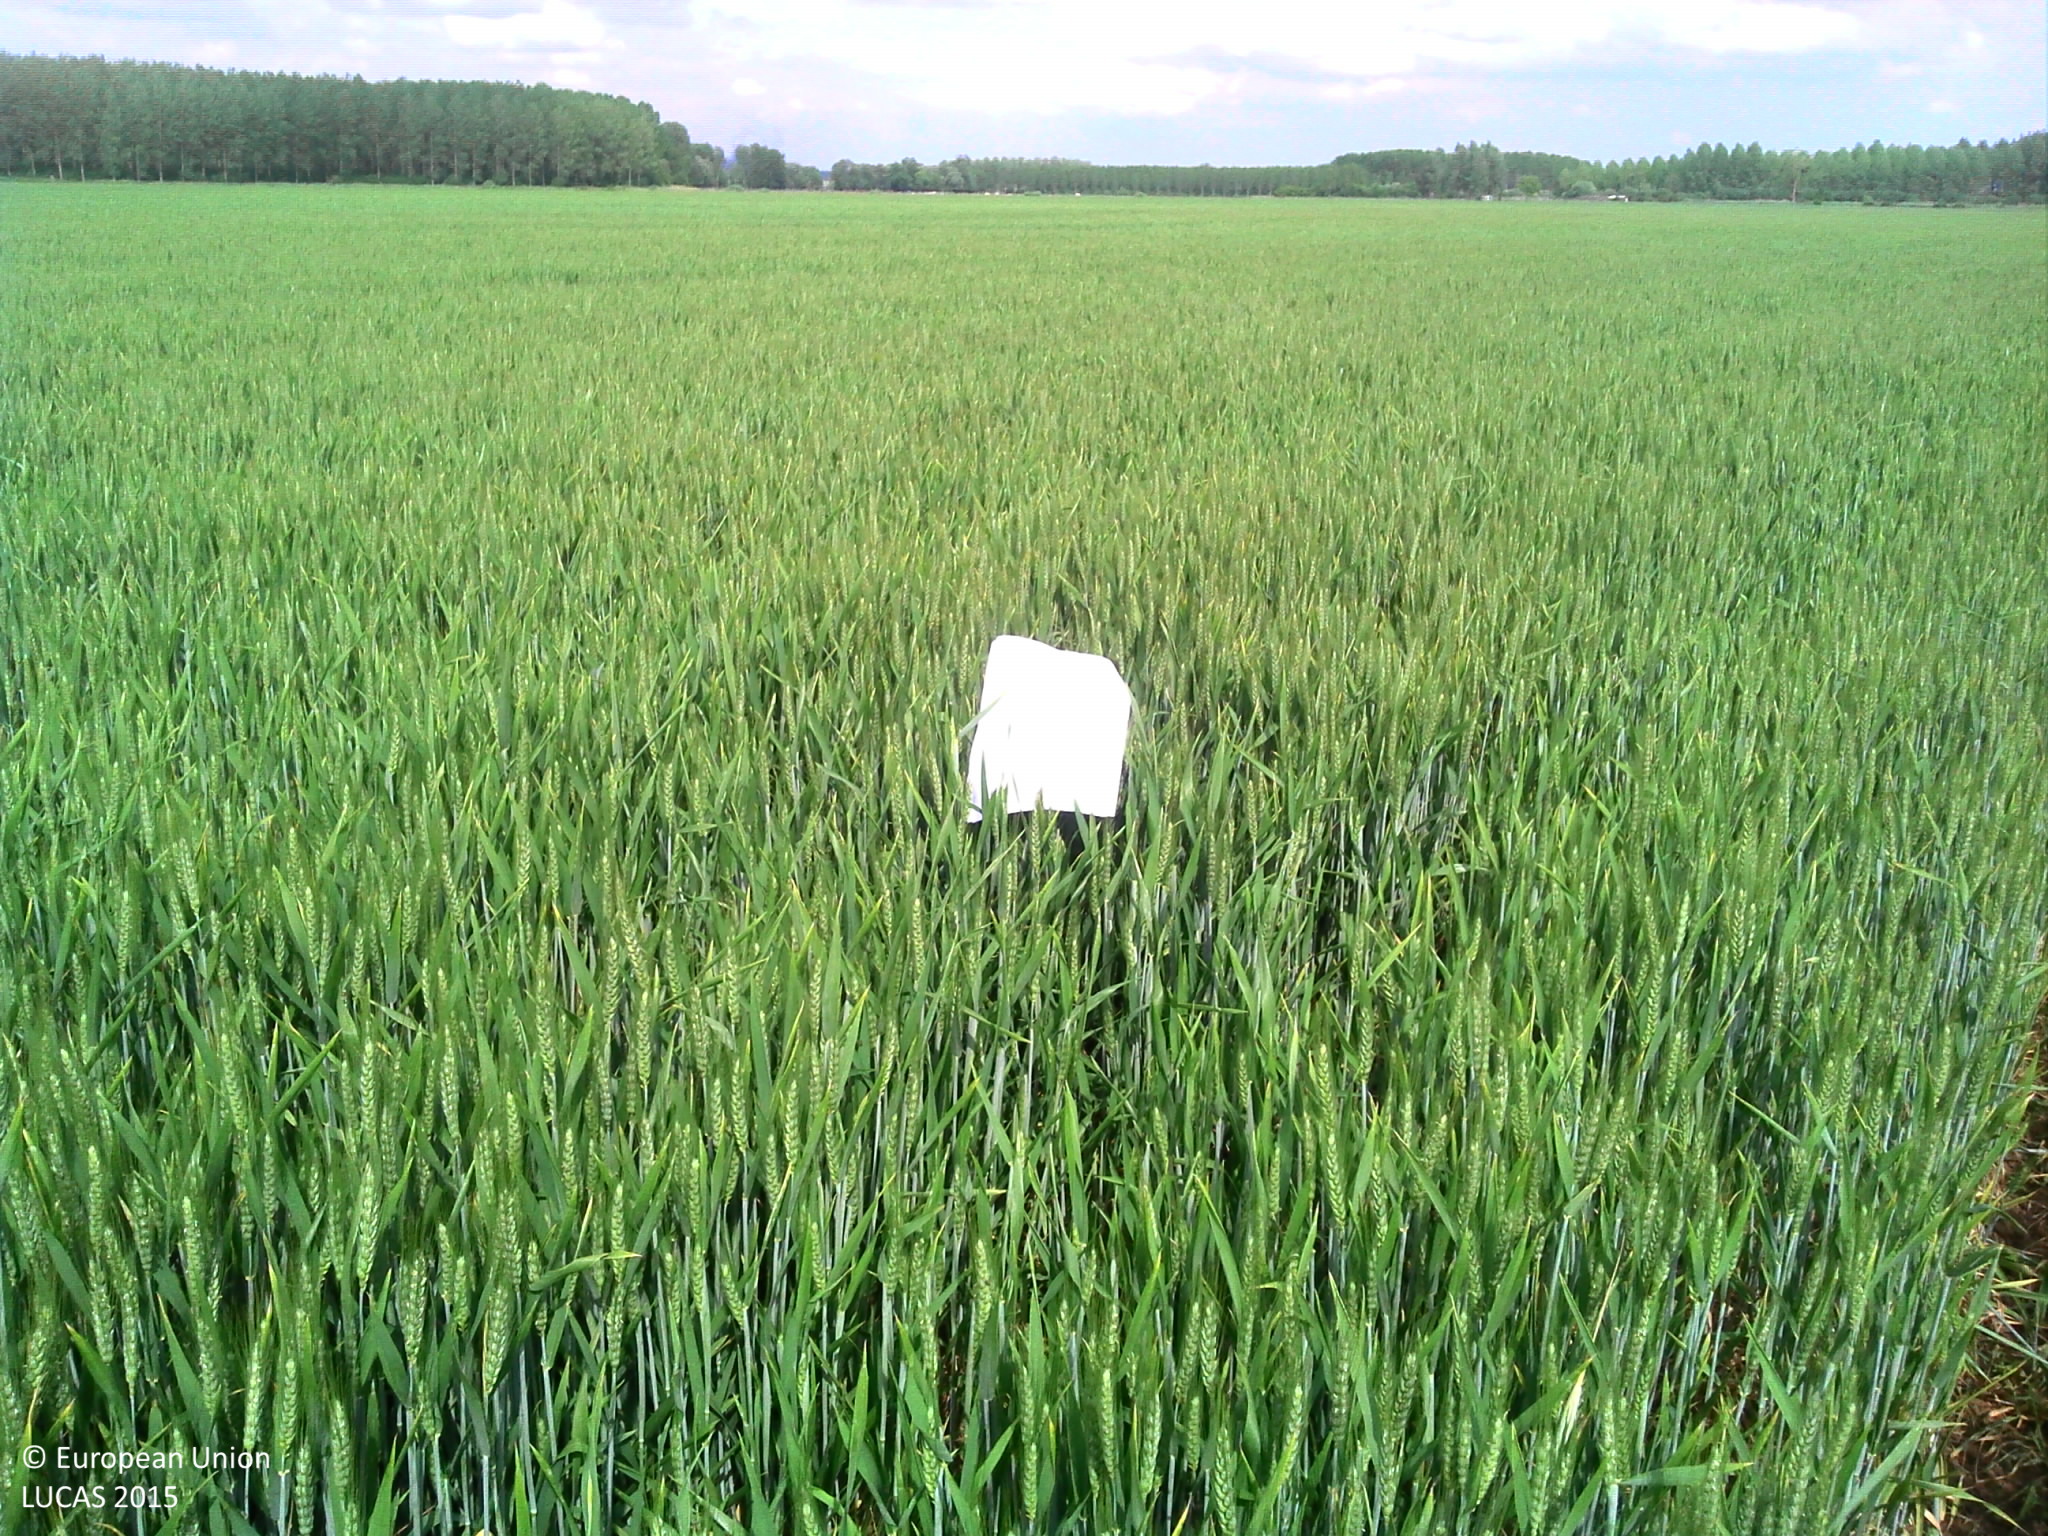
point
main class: Cropland
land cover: Common wheat
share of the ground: > 75 %
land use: Agriculture (excluding fallow land and kitchen gardens)
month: May
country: FR
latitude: 48.5892
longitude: 4.8325
